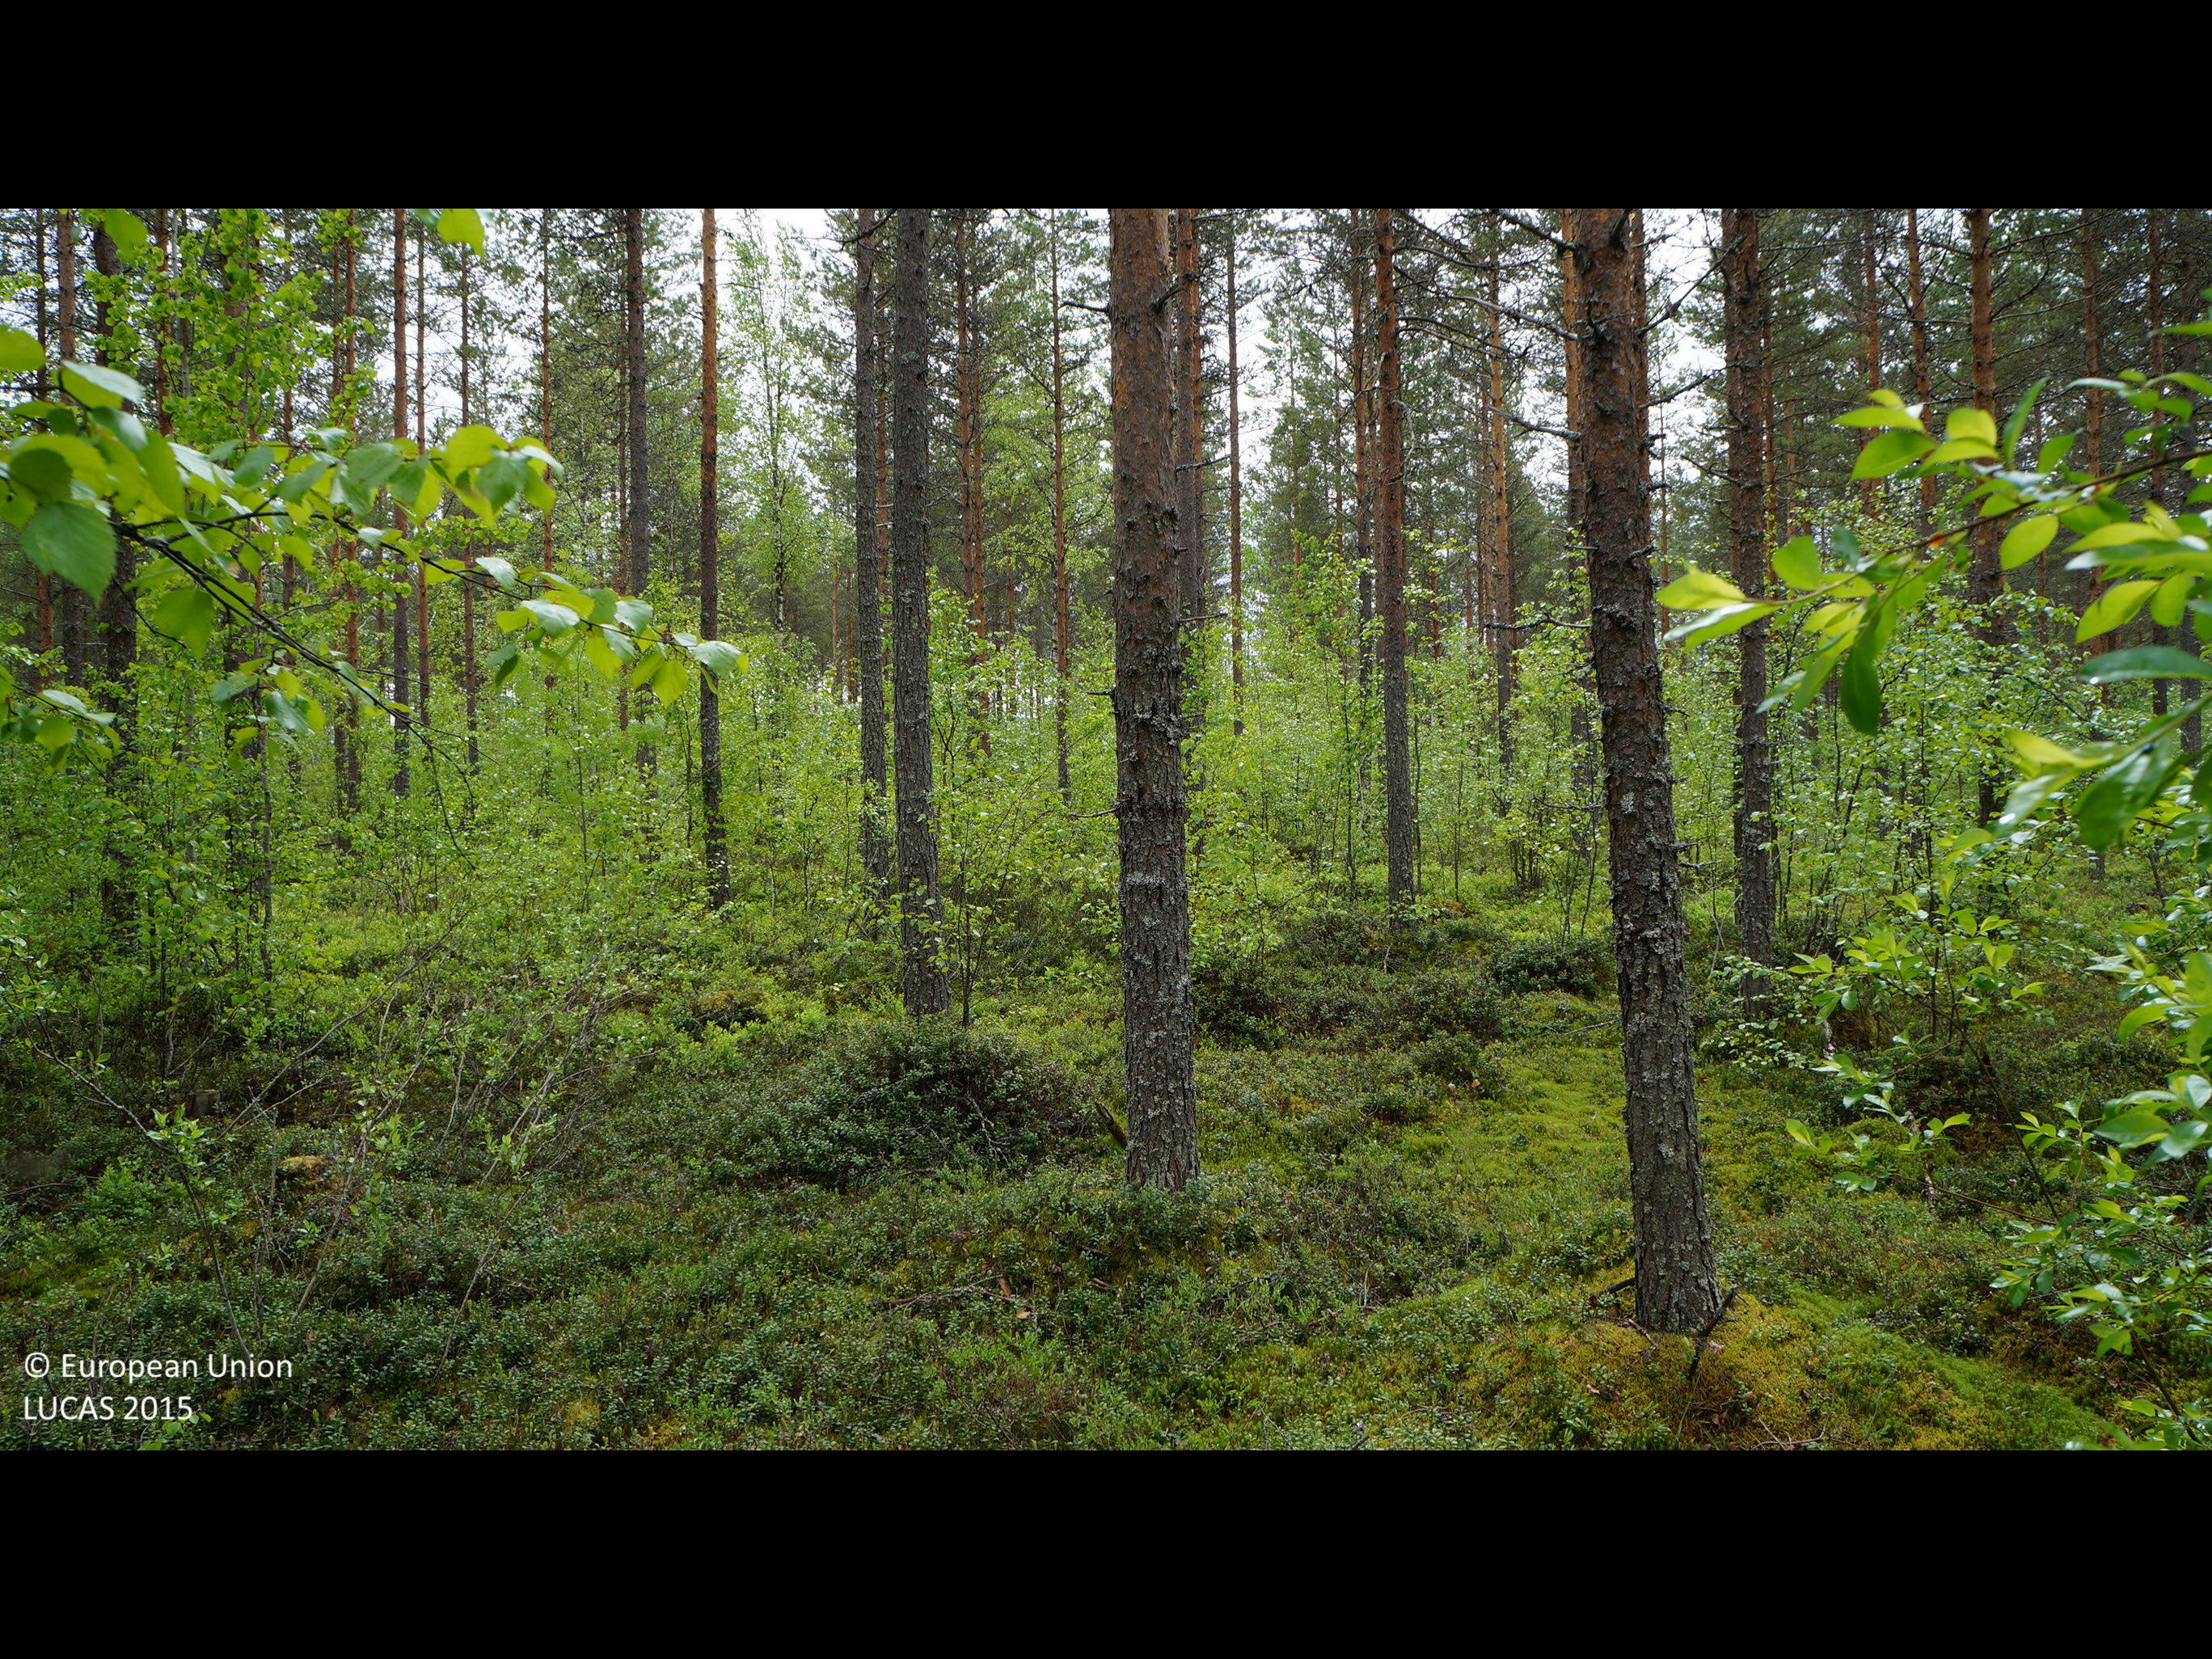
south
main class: Woodland
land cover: Pine dominated mixed woodland
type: boreal forest
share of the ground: 50 - 75 %
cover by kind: coniferous forest trees 50 %, broadleaved forest trees 20 %, shrubs 20 %, herbaceous plants 5 %, lichens and mosses 5 %
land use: Forestry
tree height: > 5 m
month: June
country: FI
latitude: 64.2693
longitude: 25.3879
